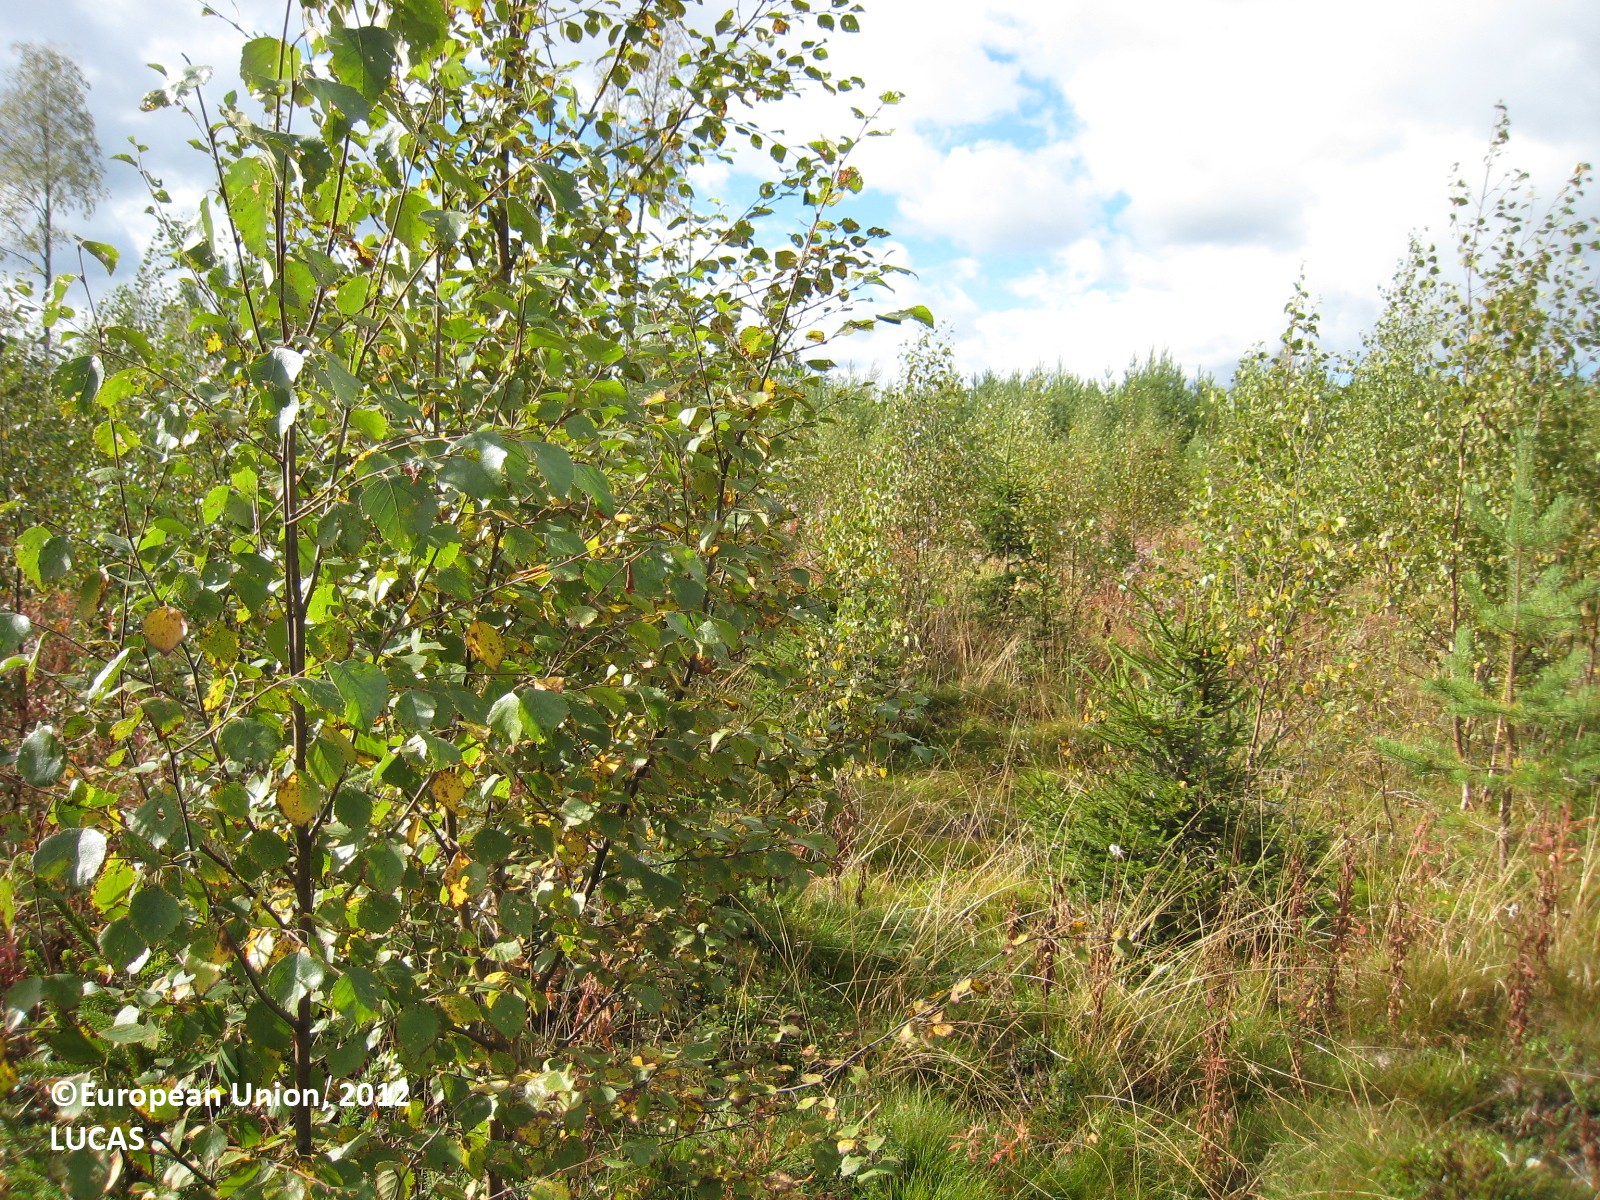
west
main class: Woodland
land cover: Other mixed woodland
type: boreal forest
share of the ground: 50 - 75 %
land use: Forestry
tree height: > 5 m
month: September
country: FI
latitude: 63.0370
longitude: 26.7240
